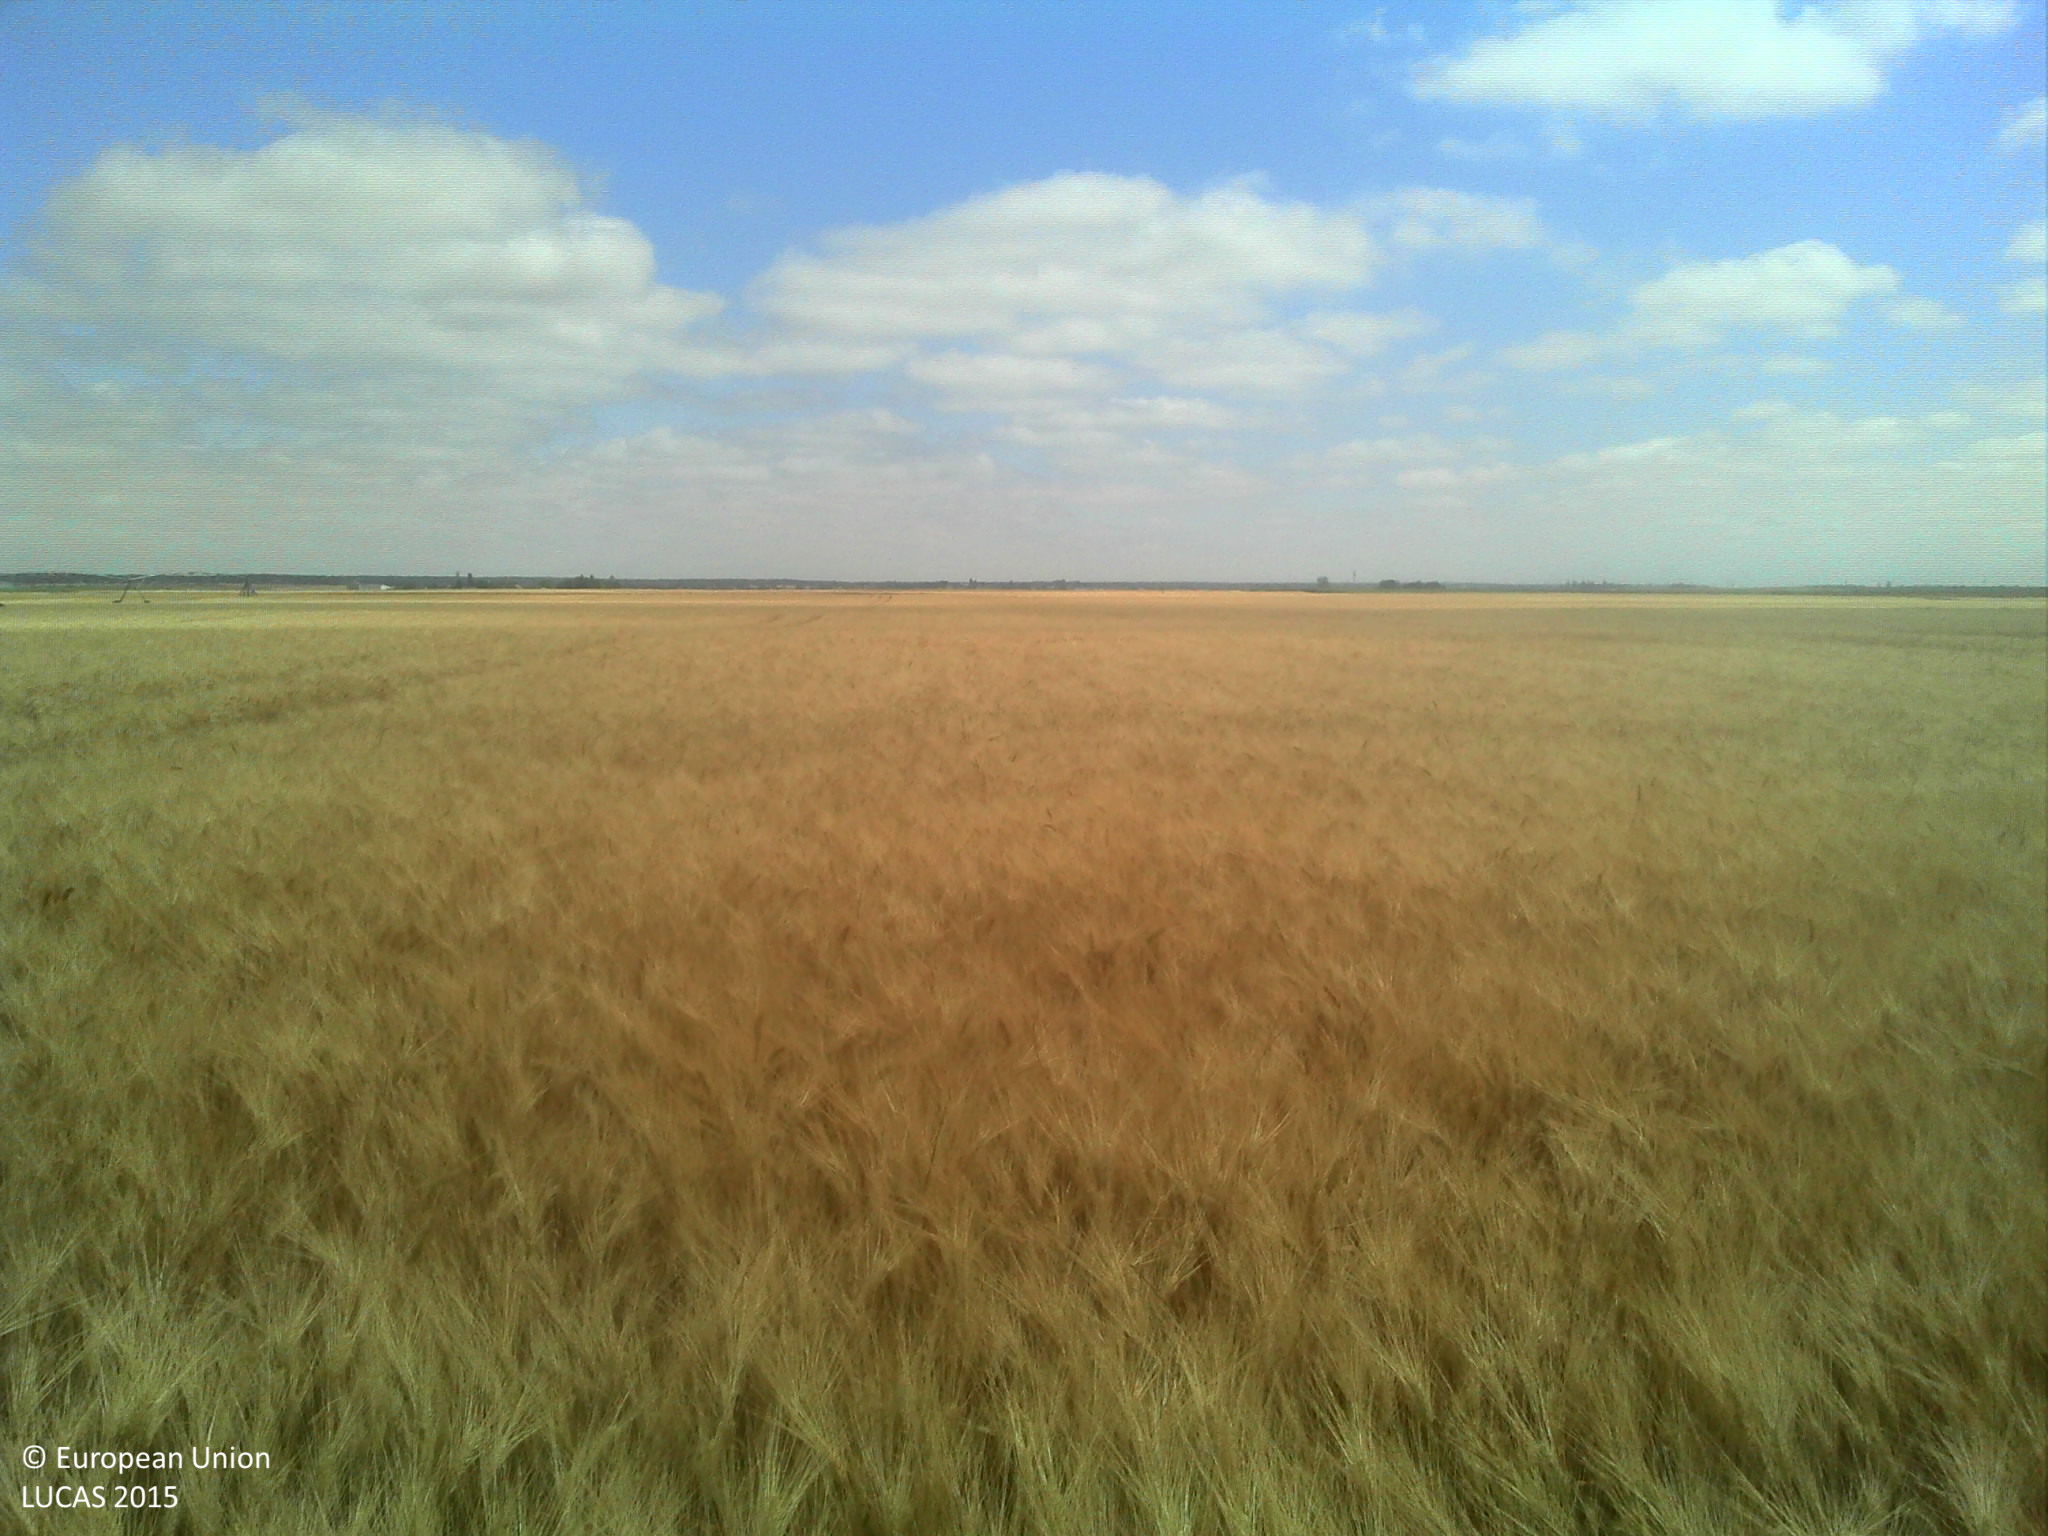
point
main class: Cropland
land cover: Durum wheat
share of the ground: > 75 %
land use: Agriculture (excluding fallow land and kitchen gardens)
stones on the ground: < 10 %
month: July
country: FR
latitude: 47.8081
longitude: 1.3176
